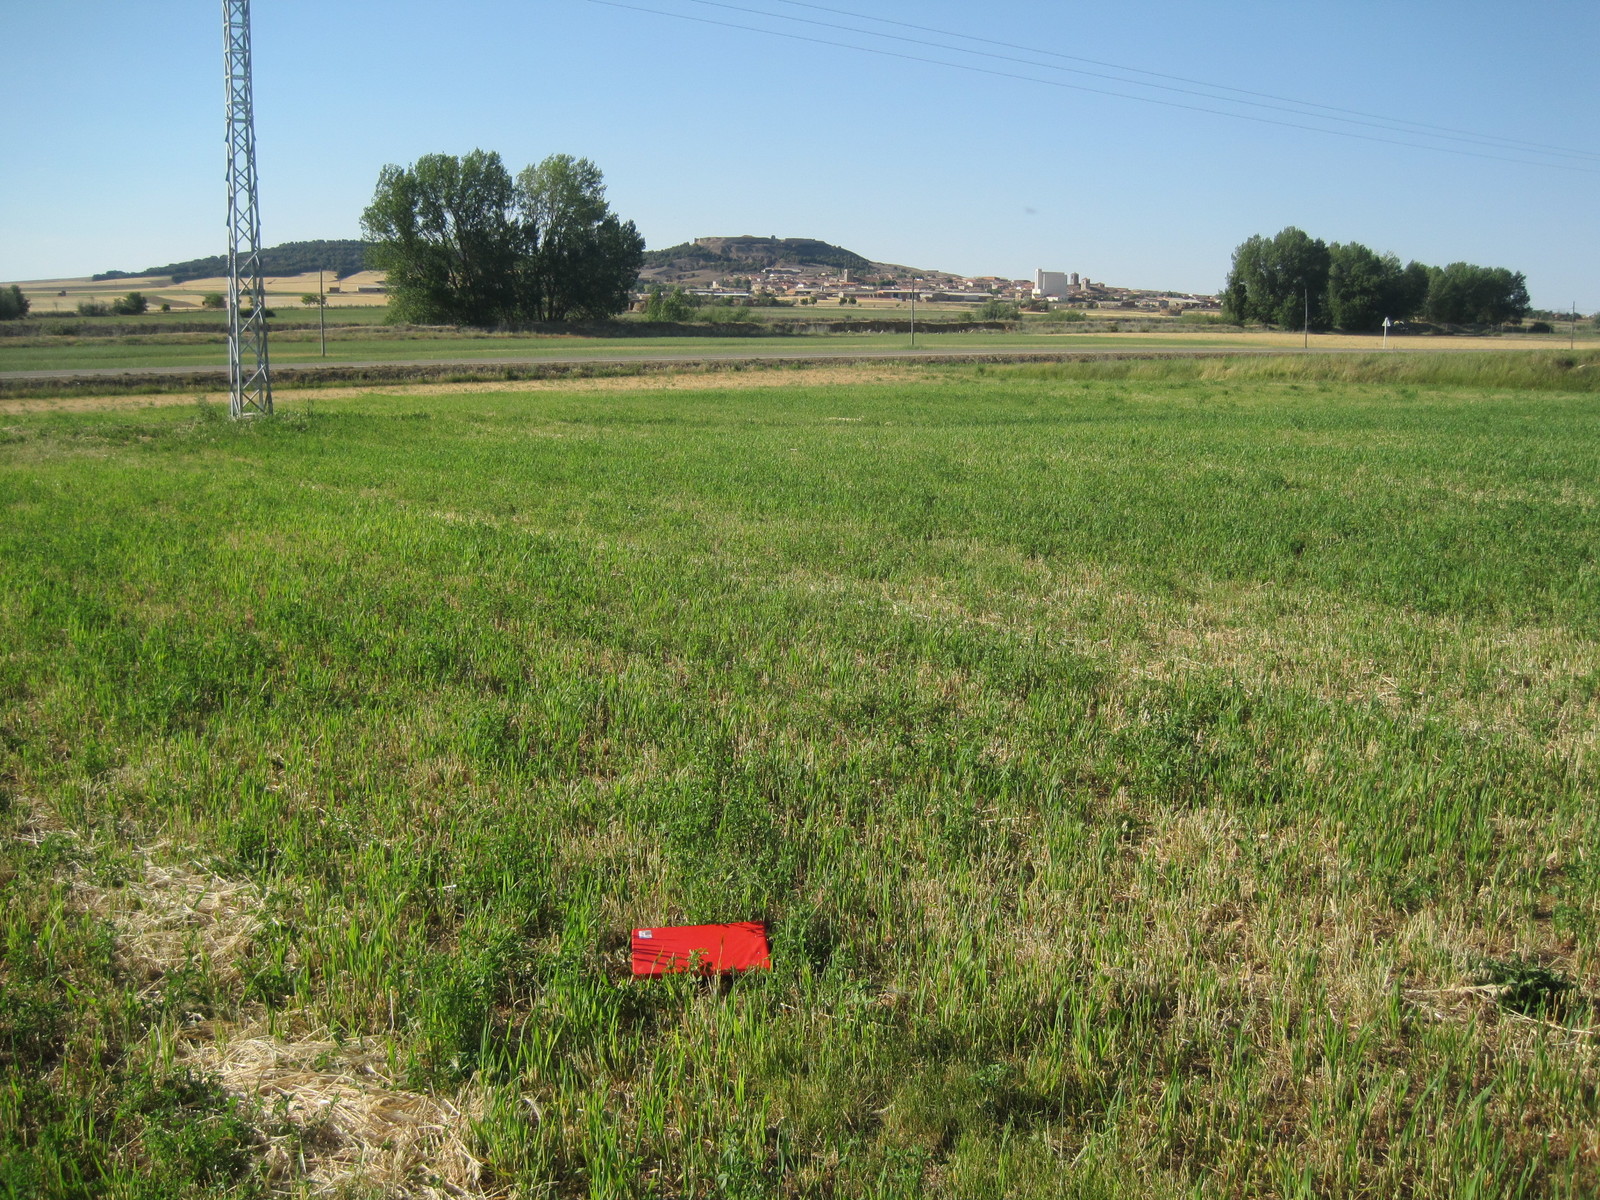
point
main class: Cropland
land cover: Mixed cereals for fodder
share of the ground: > 75 %
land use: Agriculture (excluding fallow land and kitchen gardens)
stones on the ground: 10 - 25 %
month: June
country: ES
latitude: 41.7990
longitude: -5.1587
